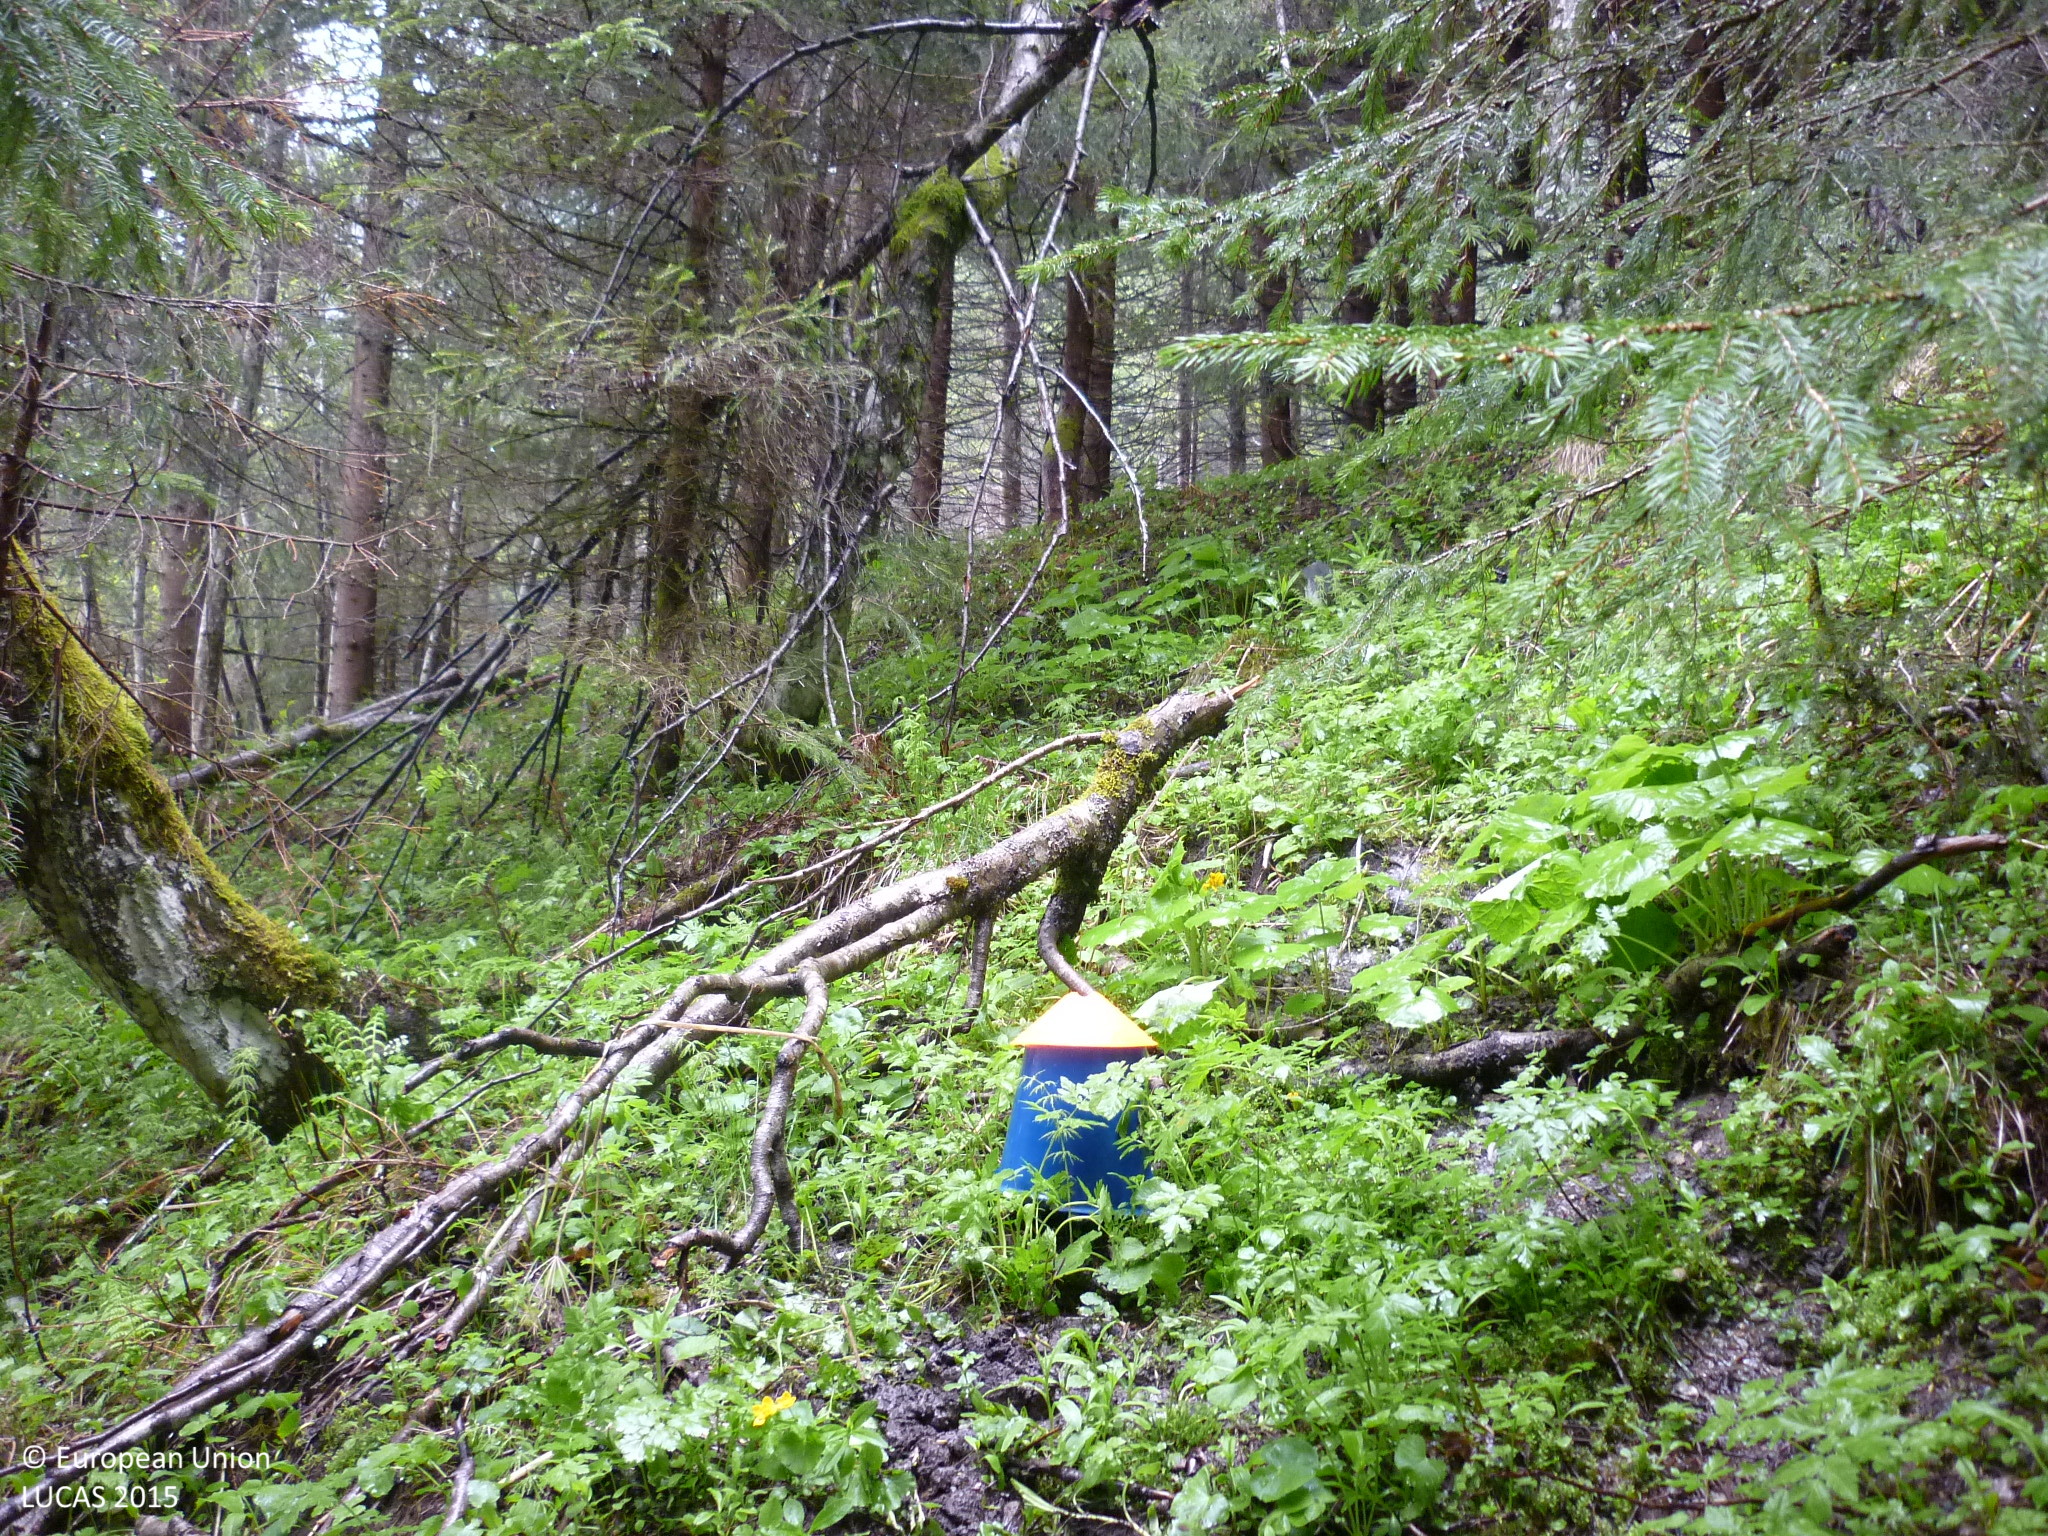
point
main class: Woodland
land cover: Spruce dominated coniferous woodland
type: alpine coniferous forest
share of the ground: > 75 %
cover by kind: coniferous forest trees 70 %, broadleaved forest trees 15 %, herbaceous plants 15 %
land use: Forestry
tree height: > 5 m
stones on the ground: < 10 %
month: May
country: AT
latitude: 47.3518
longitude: 14.1686
